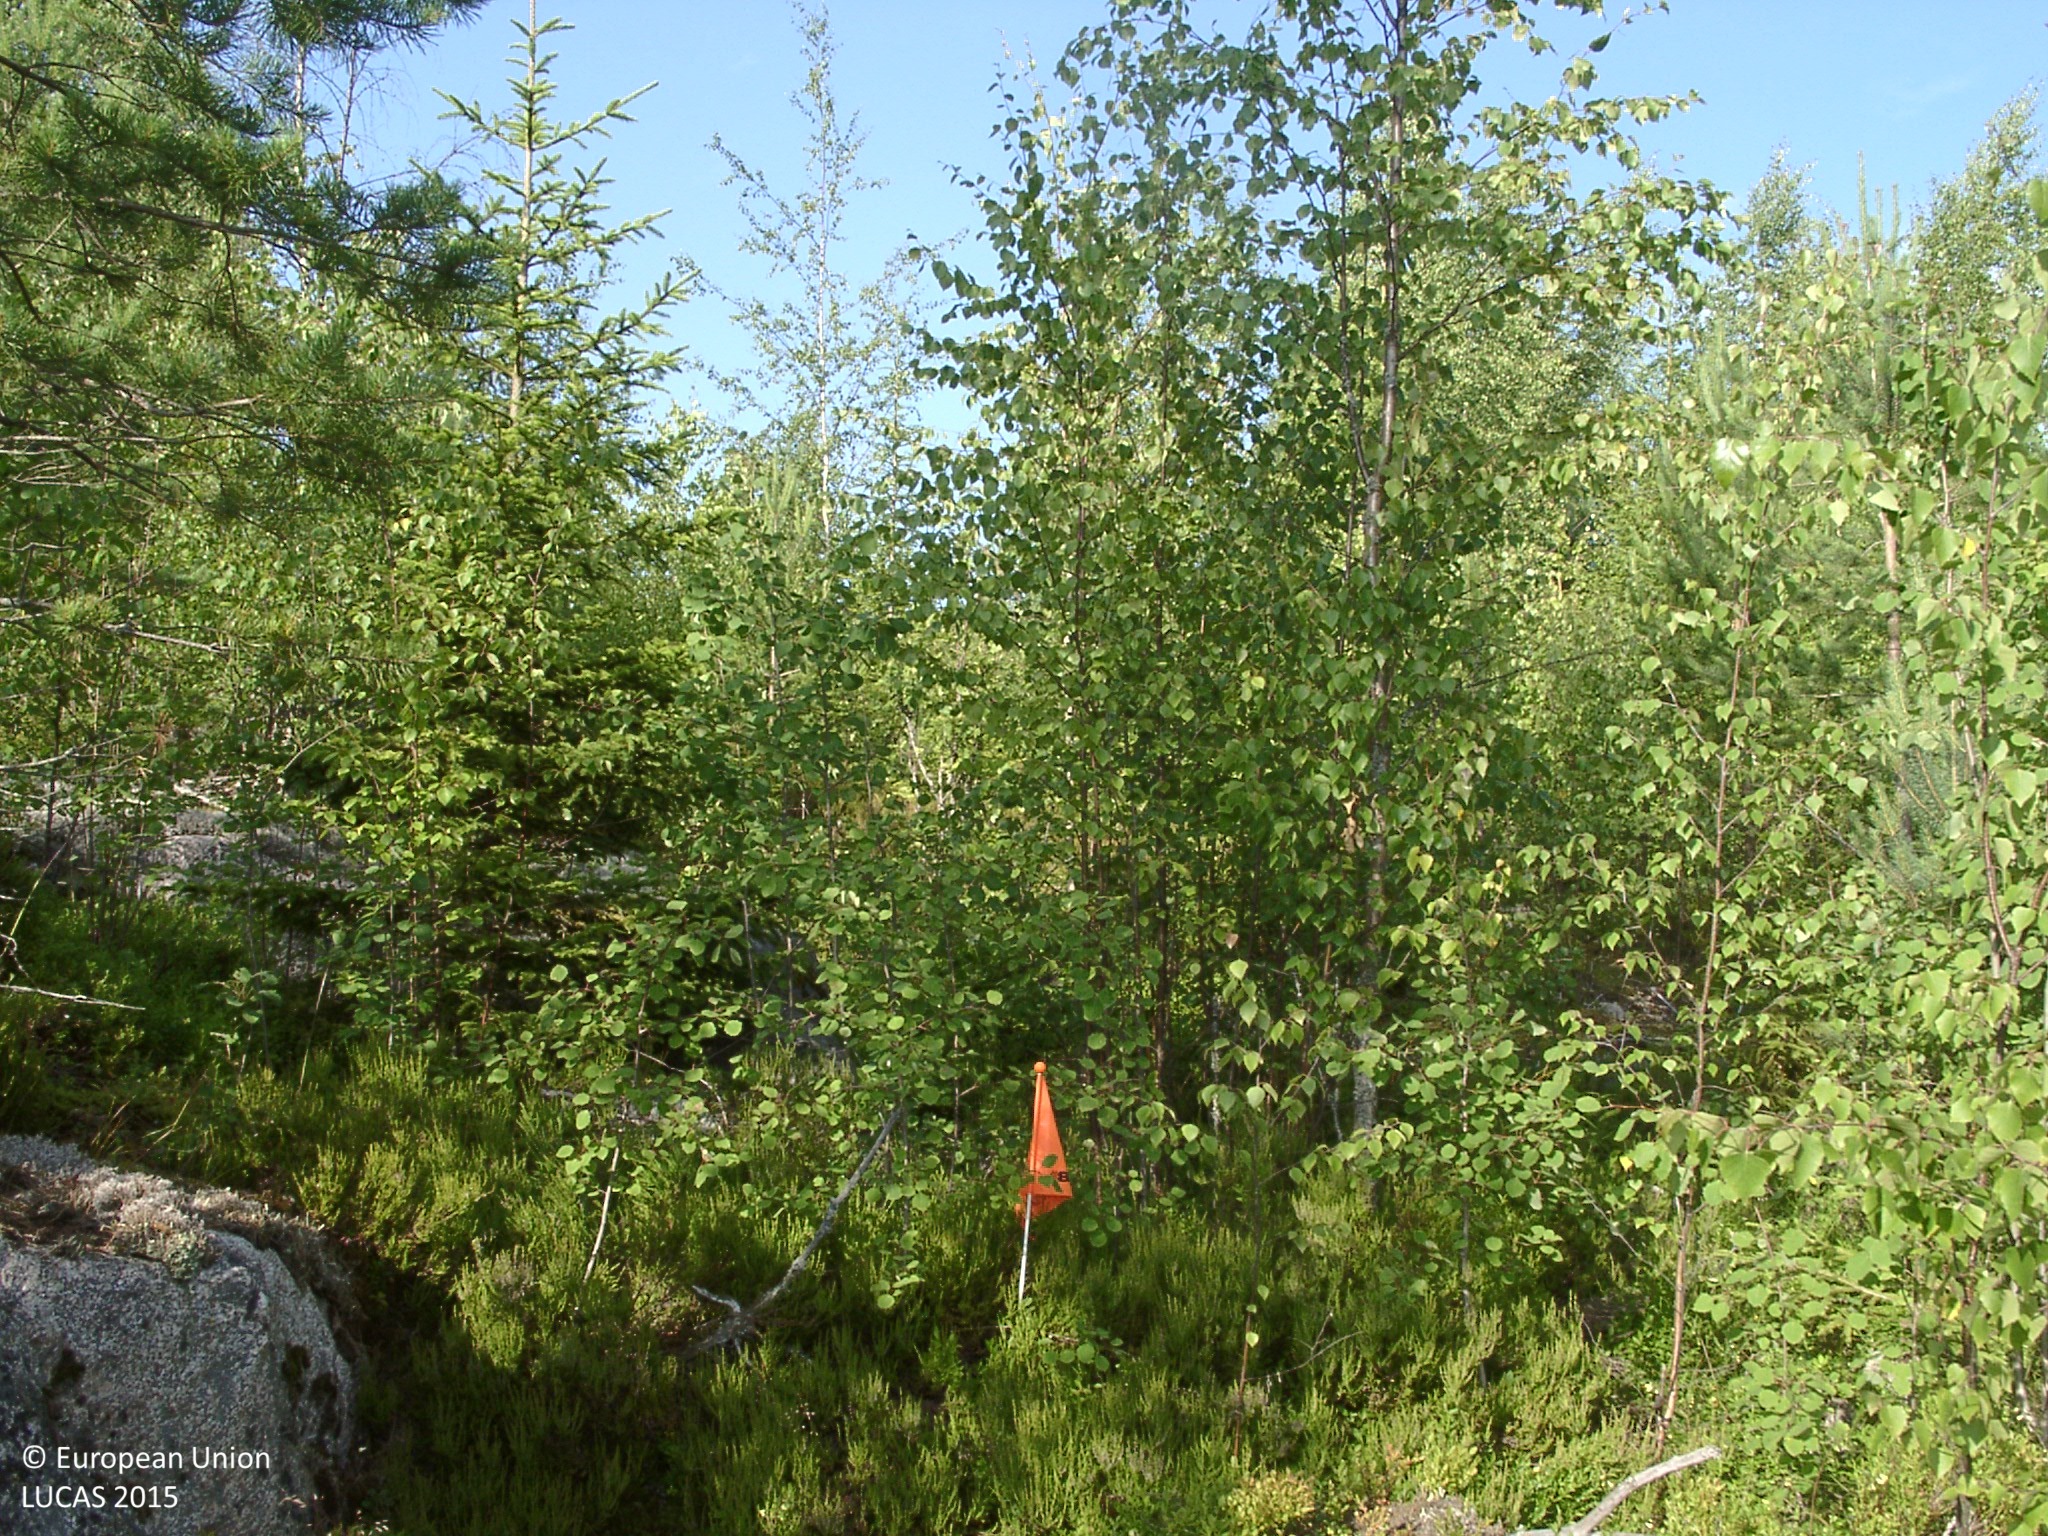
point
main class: Woodland
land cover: Pine dominated mixed woodland
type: boreal forest
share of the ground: 50 - 75 %
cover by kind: broadleaved forest trees 35 %, shrubs 25 %, coniferous forest trees 20 %, lichens and mosses 15 %, consolidated bare surface 5 %
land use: Forestry
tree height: < 5 m
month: July
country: FI
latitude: 61.7659
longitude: 24.7875
